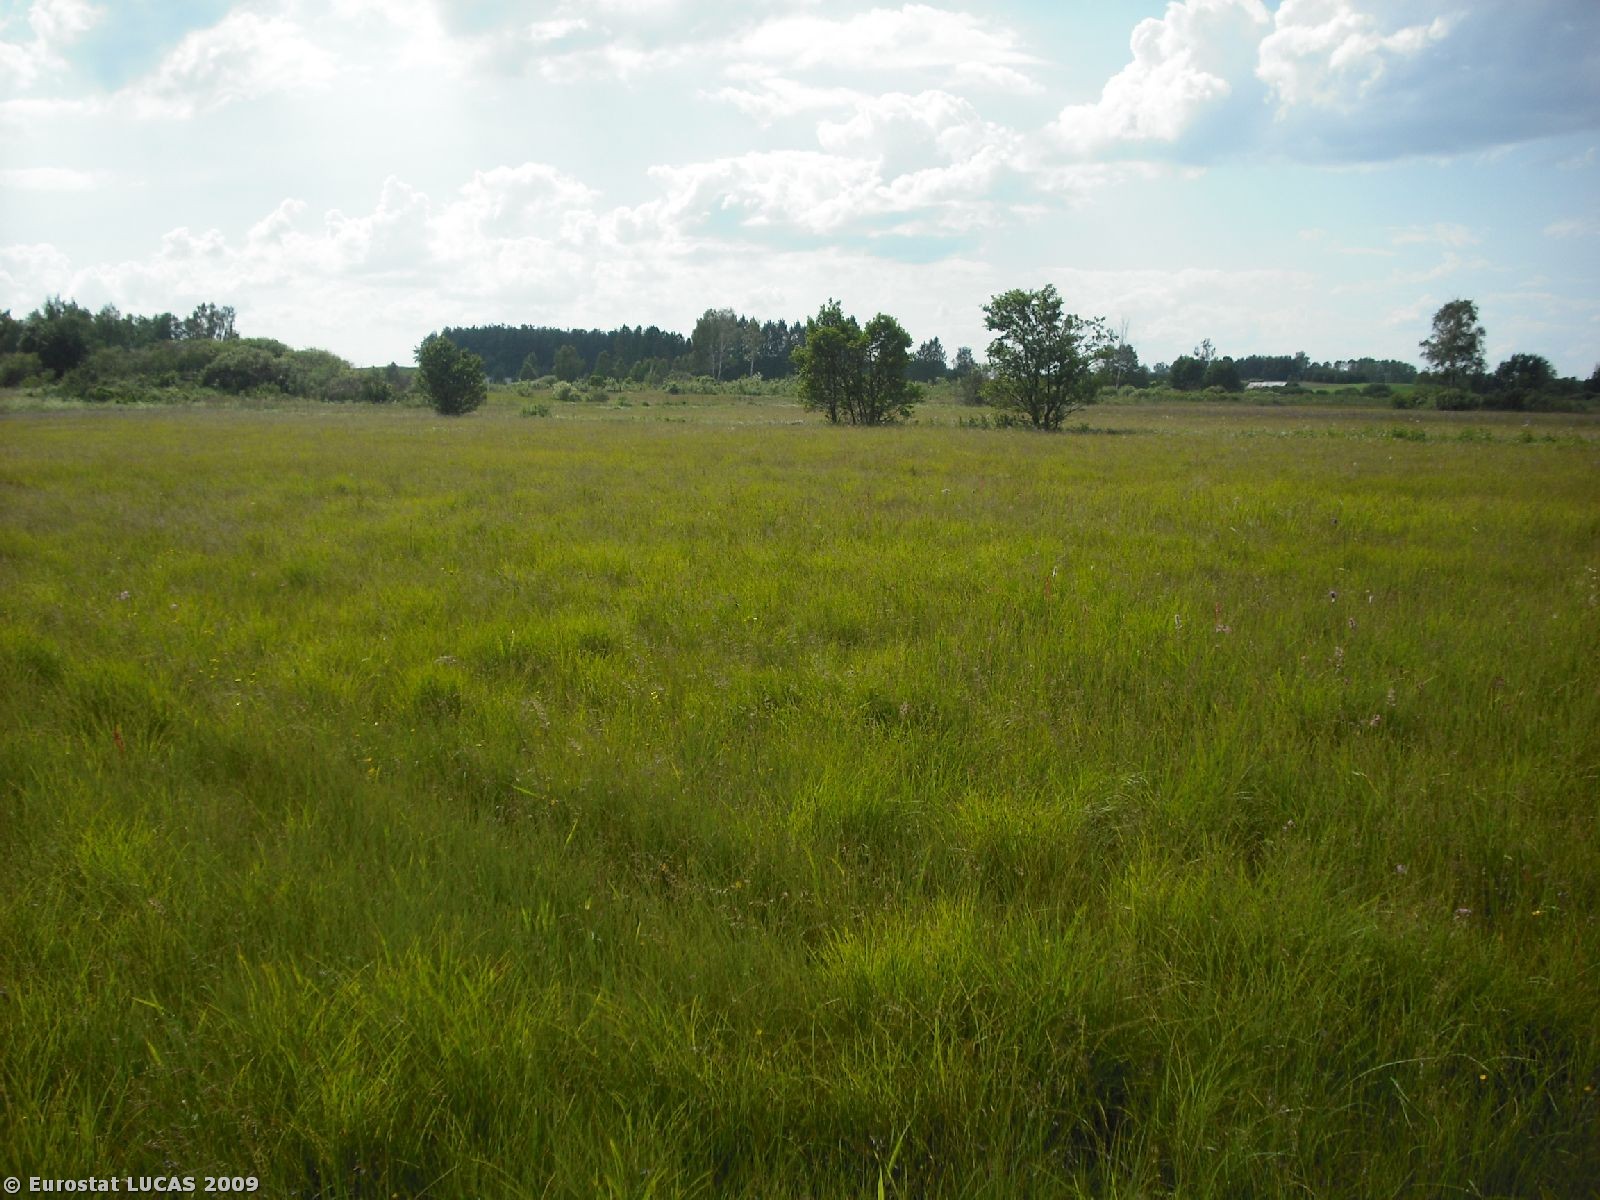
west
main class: Grassland
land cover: Grassland without tree/shrub cover
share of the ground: > 75 %
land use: Agriculture (excluding fallow land and kitchen gardens)
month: June
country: PL
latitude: 53.6722
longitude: 23.4174
